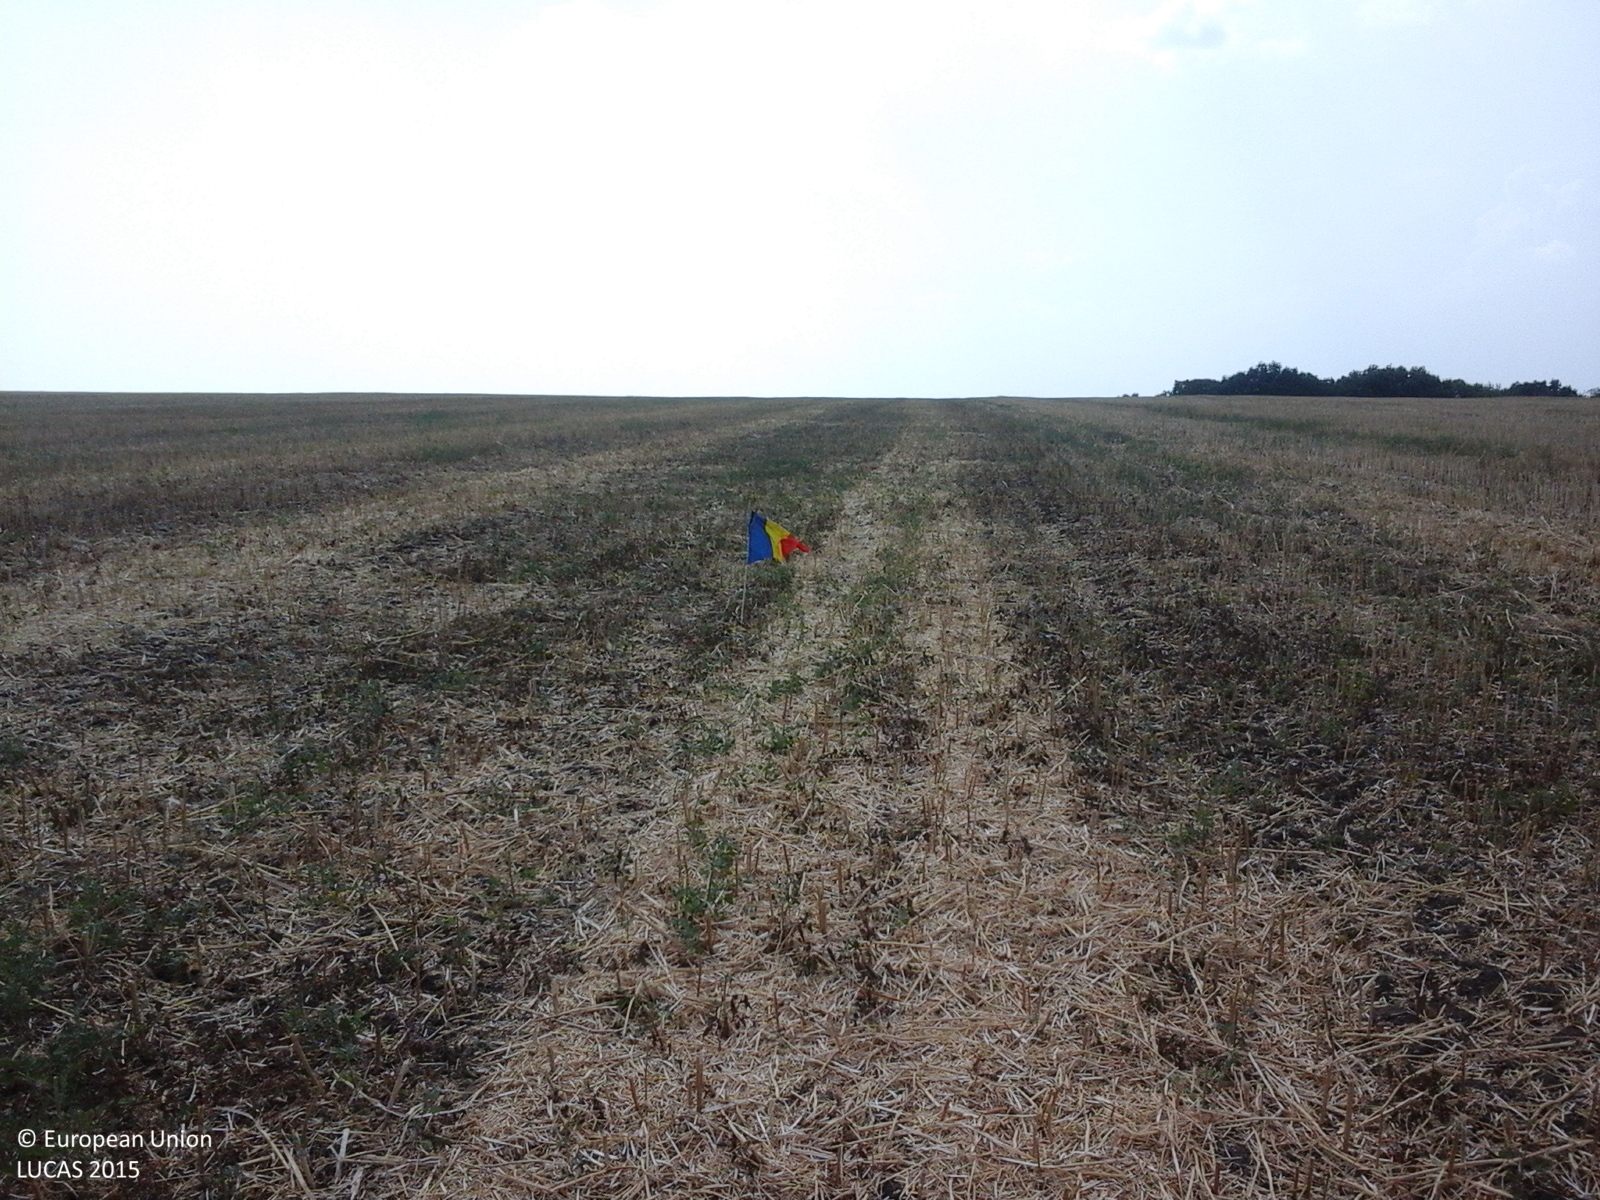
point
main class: Cropland
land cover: Rape and turnip rape
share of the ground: 10 - 25 %
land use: Agriculture (excluding fallow land and kitchen gardens)
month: July
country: RO
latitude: 45.7827
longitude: 27.9057
